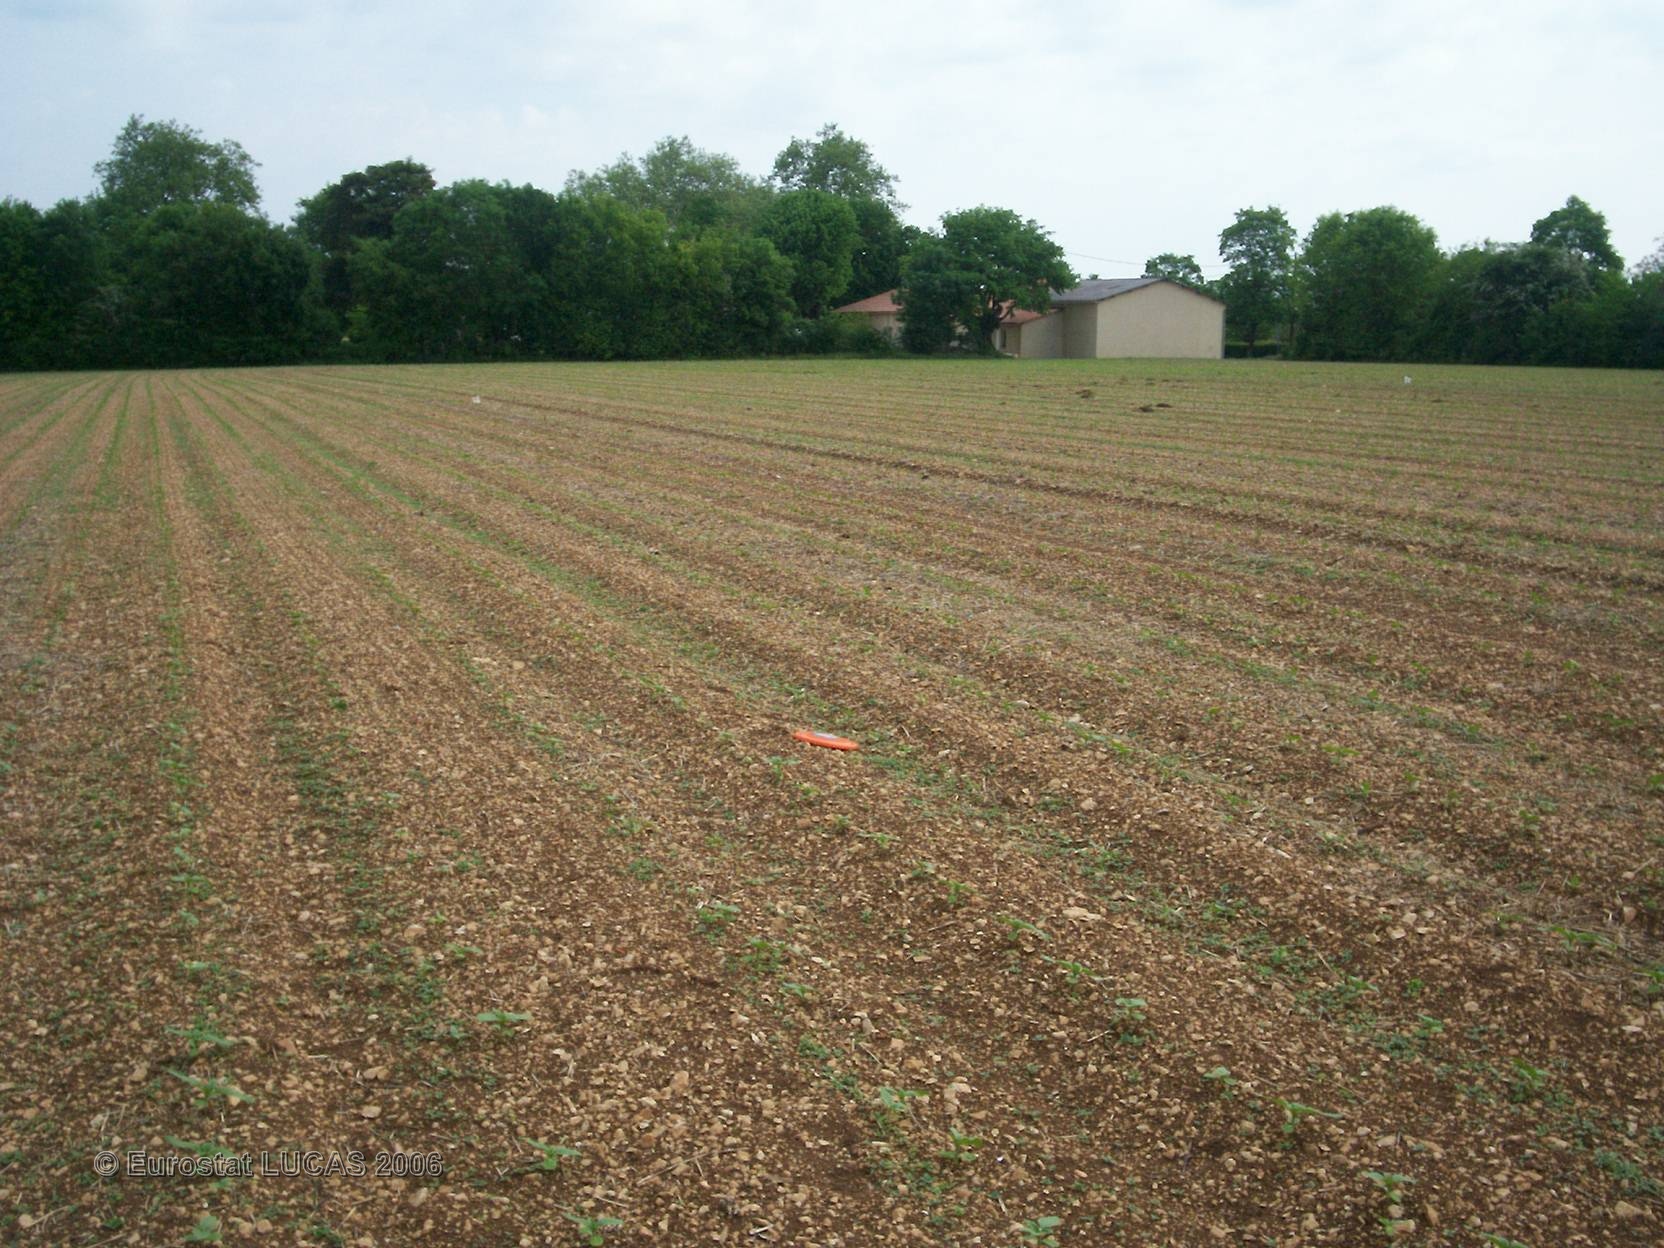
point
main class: Cropland
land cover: Sunflower
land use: Agriculture (excluding fallow land and kitchen gardens)
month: May
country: FR
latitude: 46.0778
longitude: -0.2241
